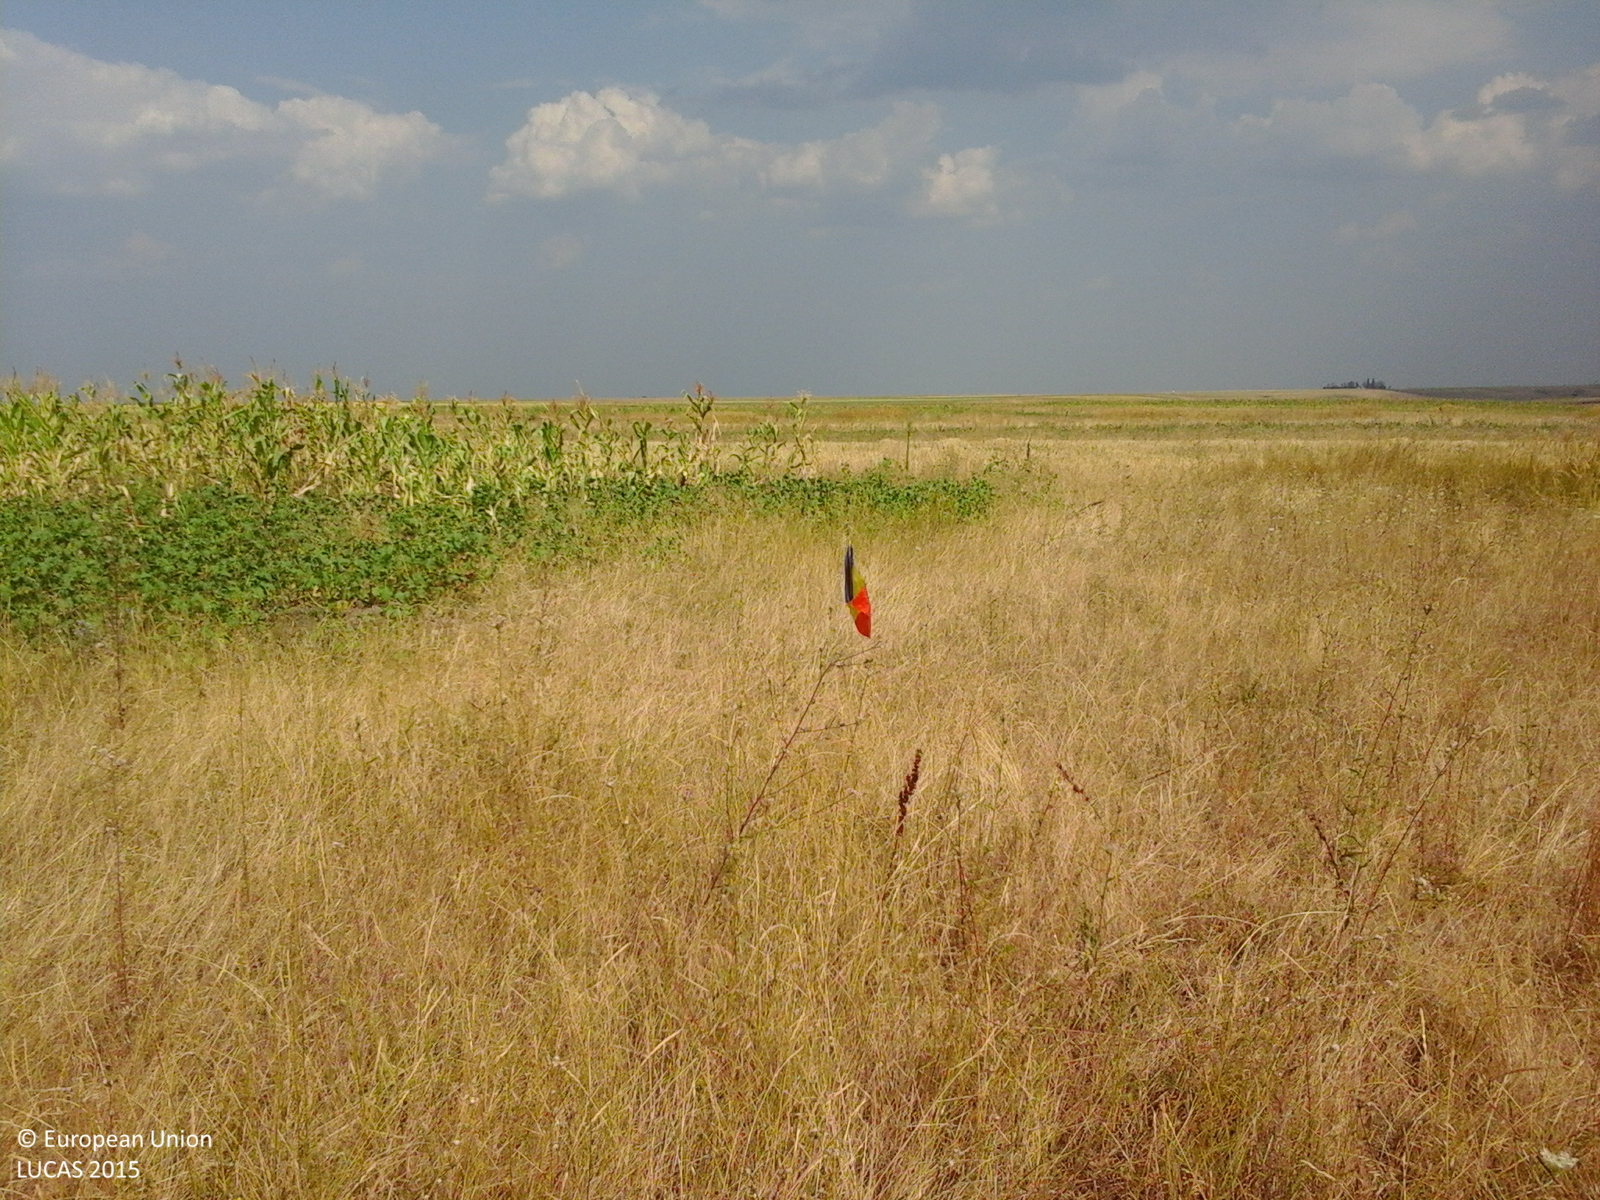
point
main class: Grassland
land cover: Spontaneously vegetated surfaces
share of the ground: > 75 %
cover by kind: herbaceous plants 100 %
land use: Fallow land
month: August
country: RO
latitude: 44.4257
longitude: 23.1228
